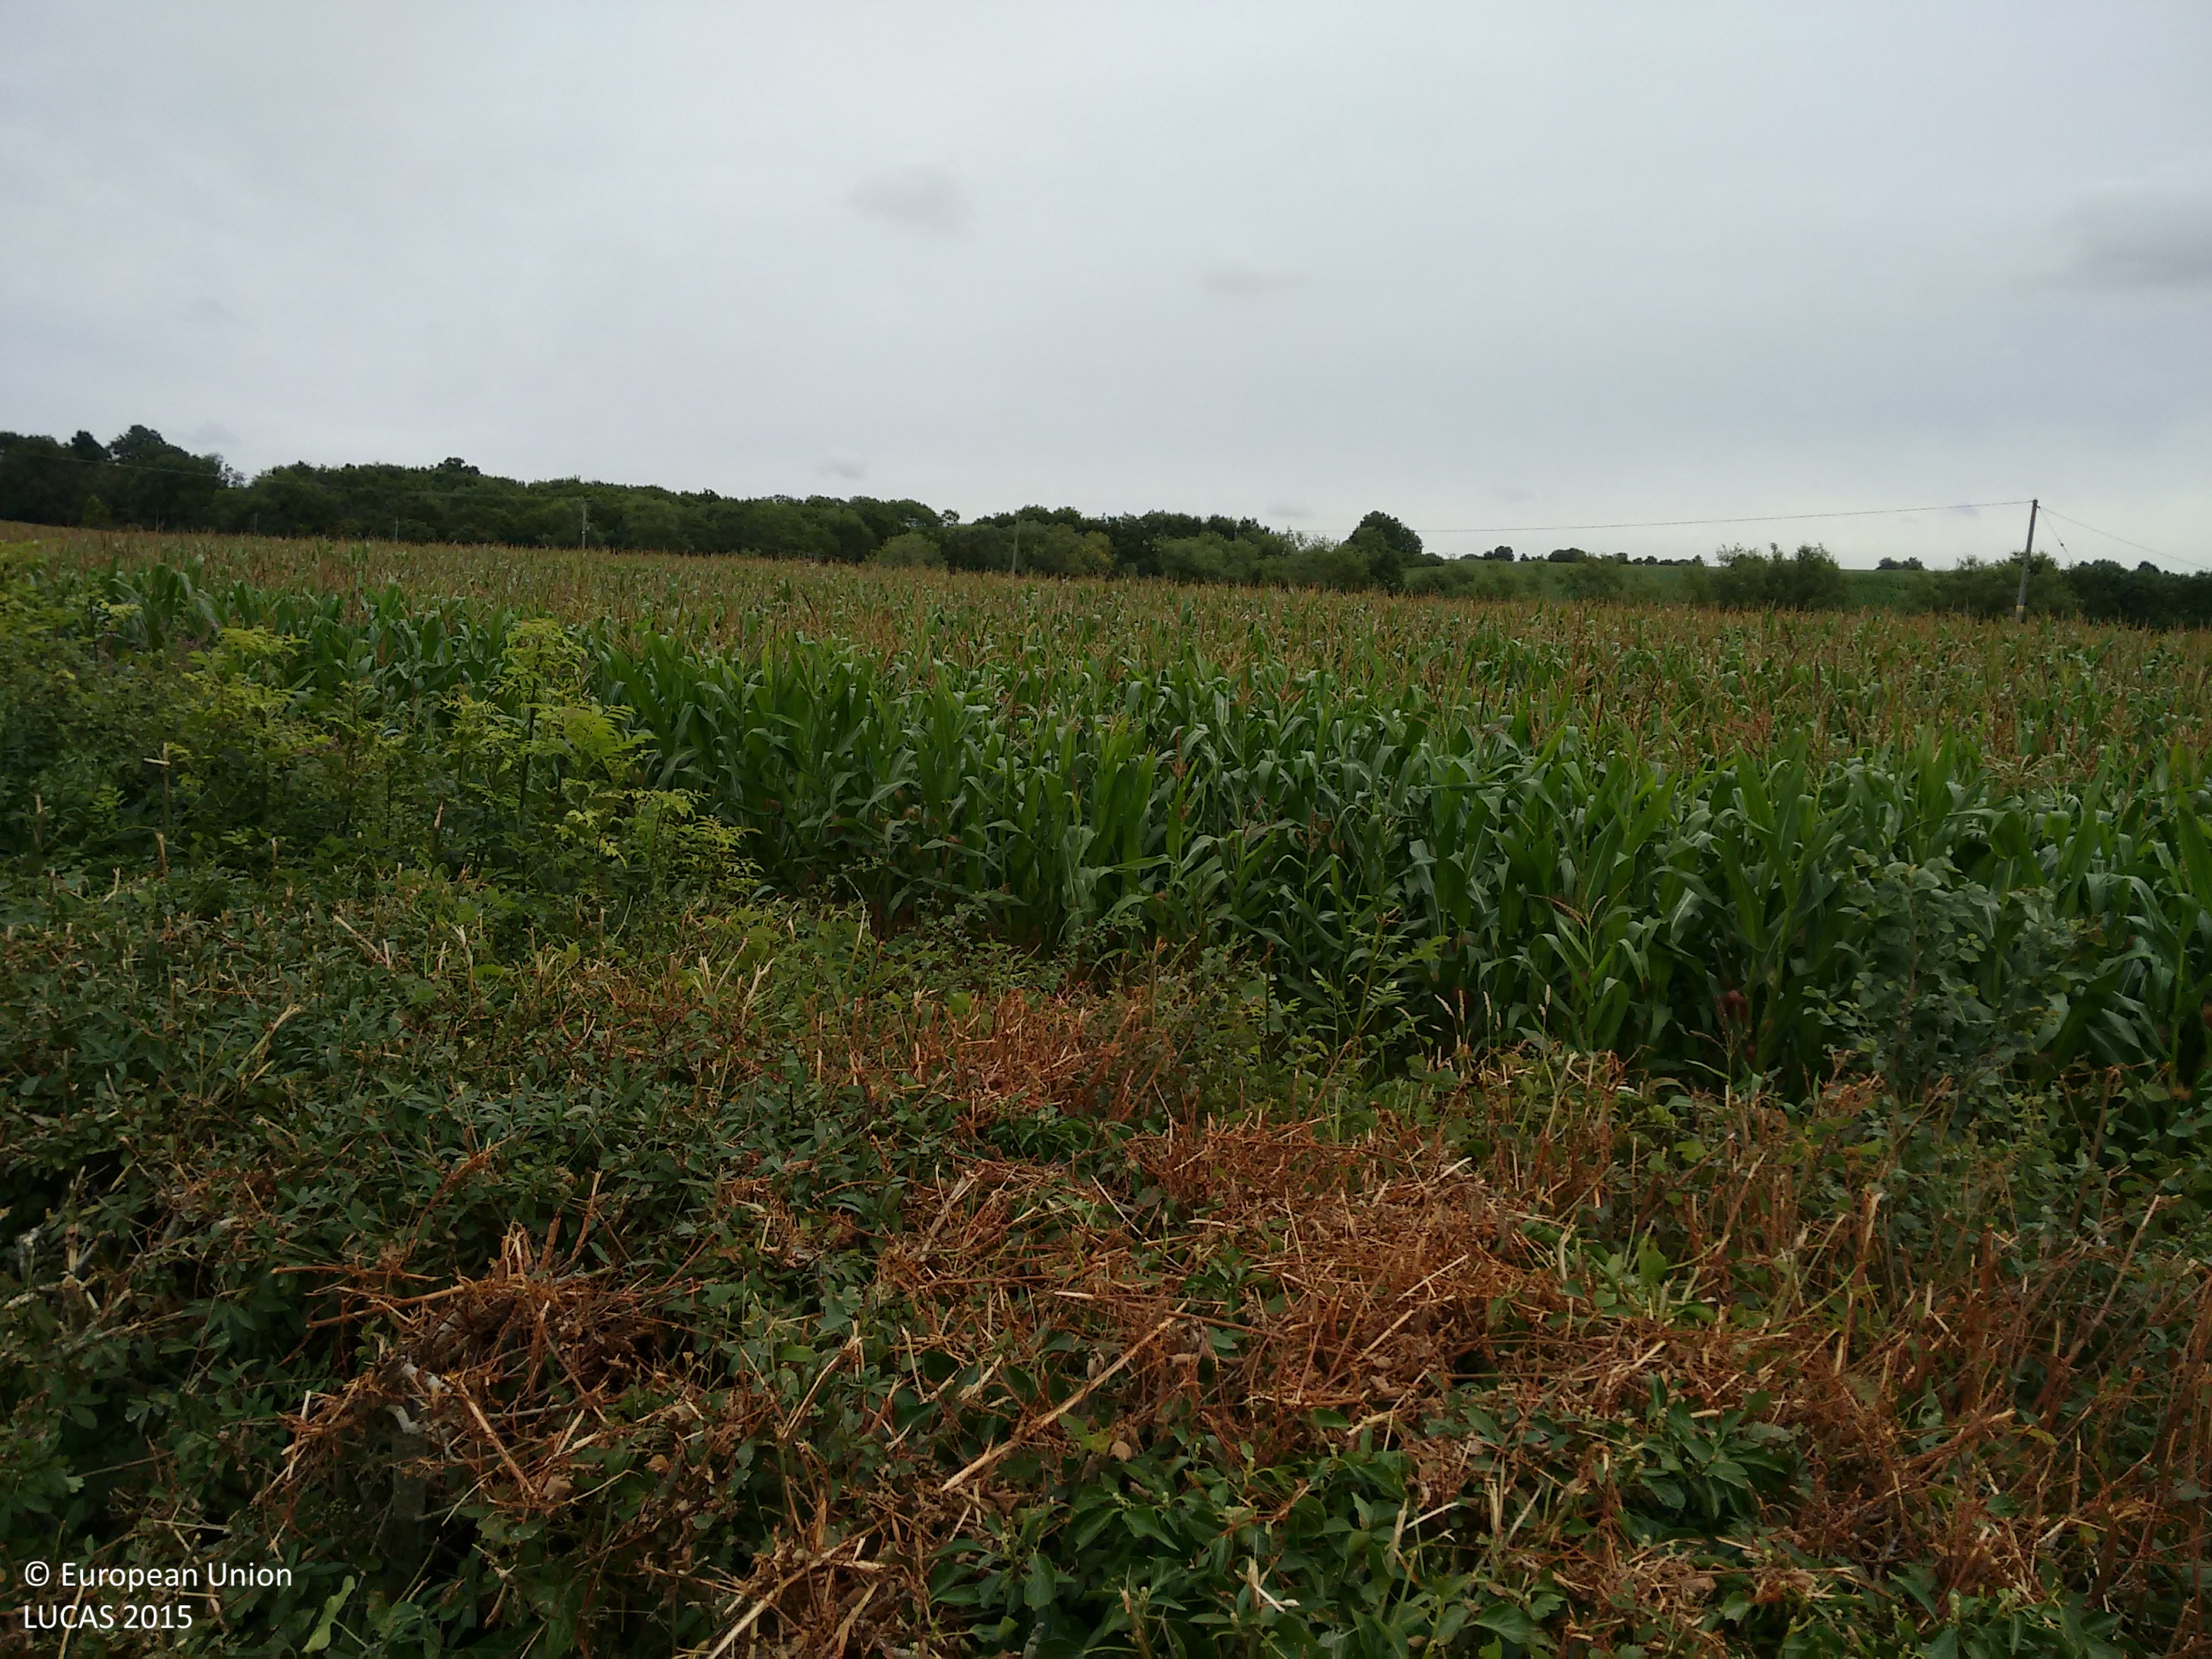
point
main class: Cropland
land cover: Maize
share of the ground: > 75 %
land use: Agriculture (excluding fallow land and kitchen gardens)
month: August
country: GB
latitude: 52.0806
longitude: -1.2101
